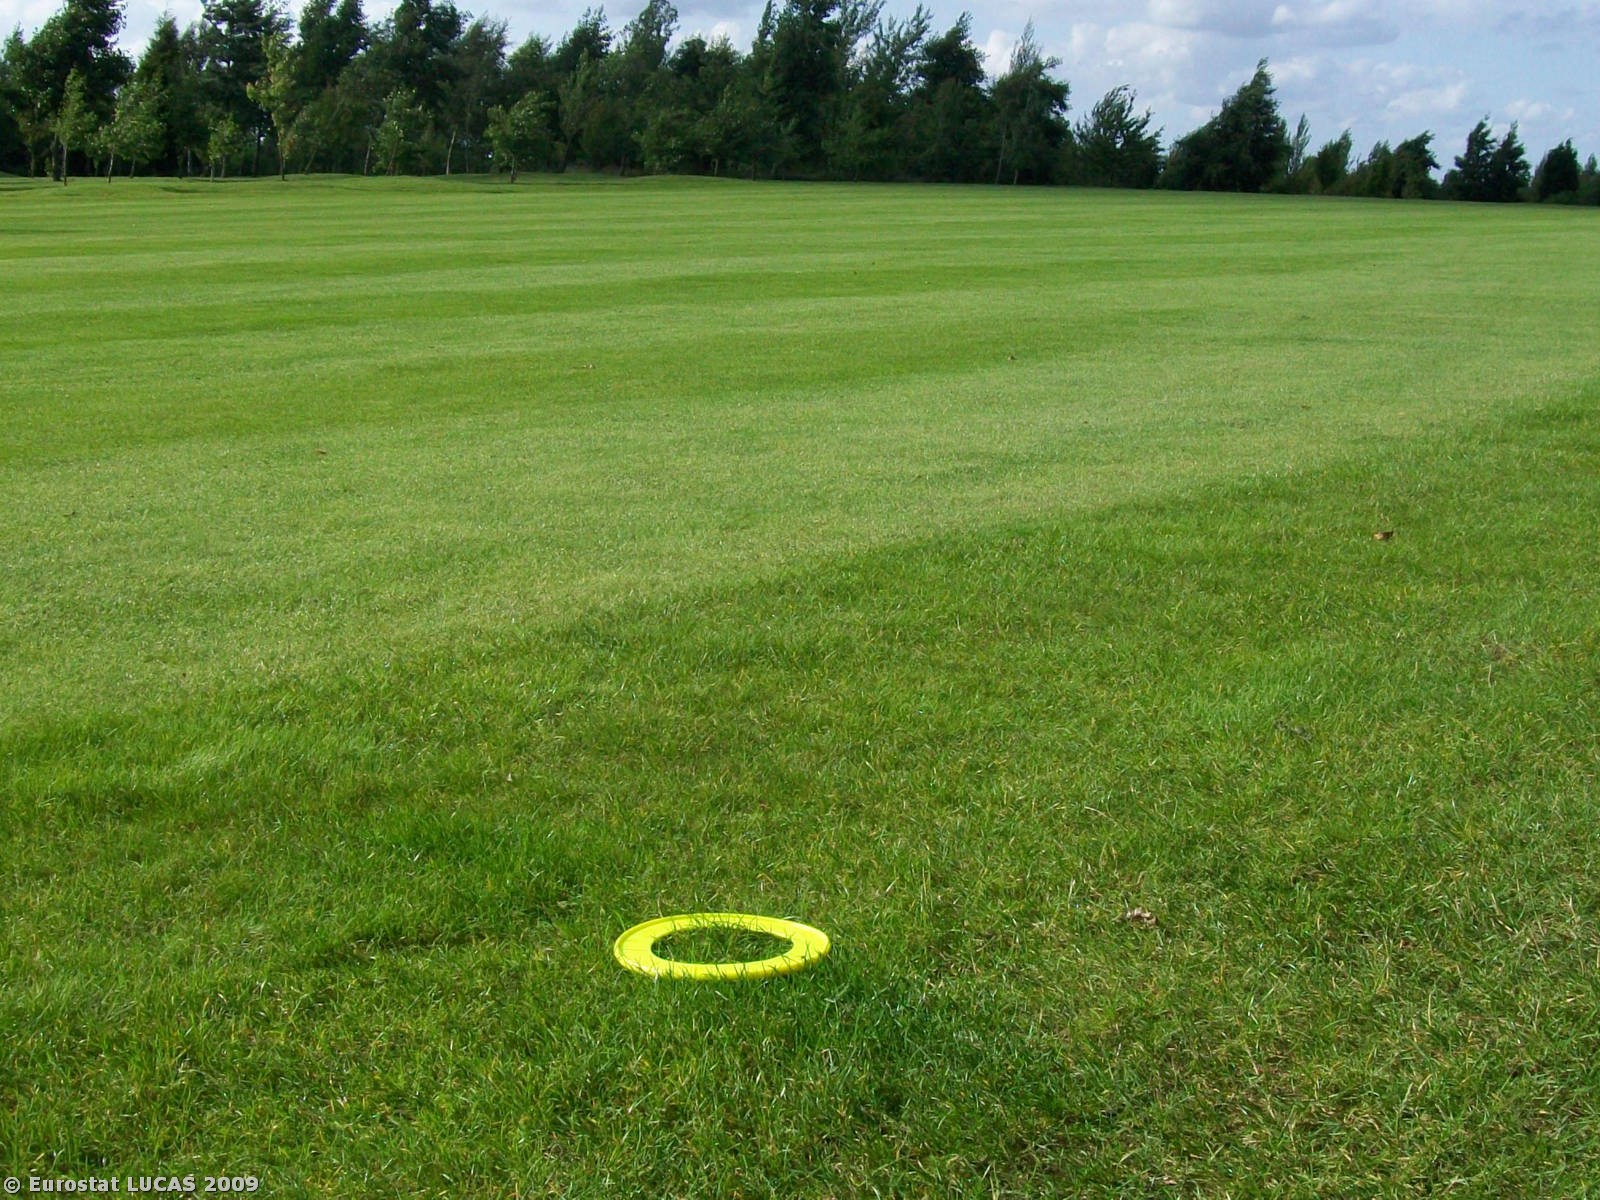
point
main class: Grassland
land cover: Grassland without tree/shrub cover
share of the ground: > 75 %
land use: Sport
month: July
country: GB
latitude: 53.2959
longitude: -1.2241
